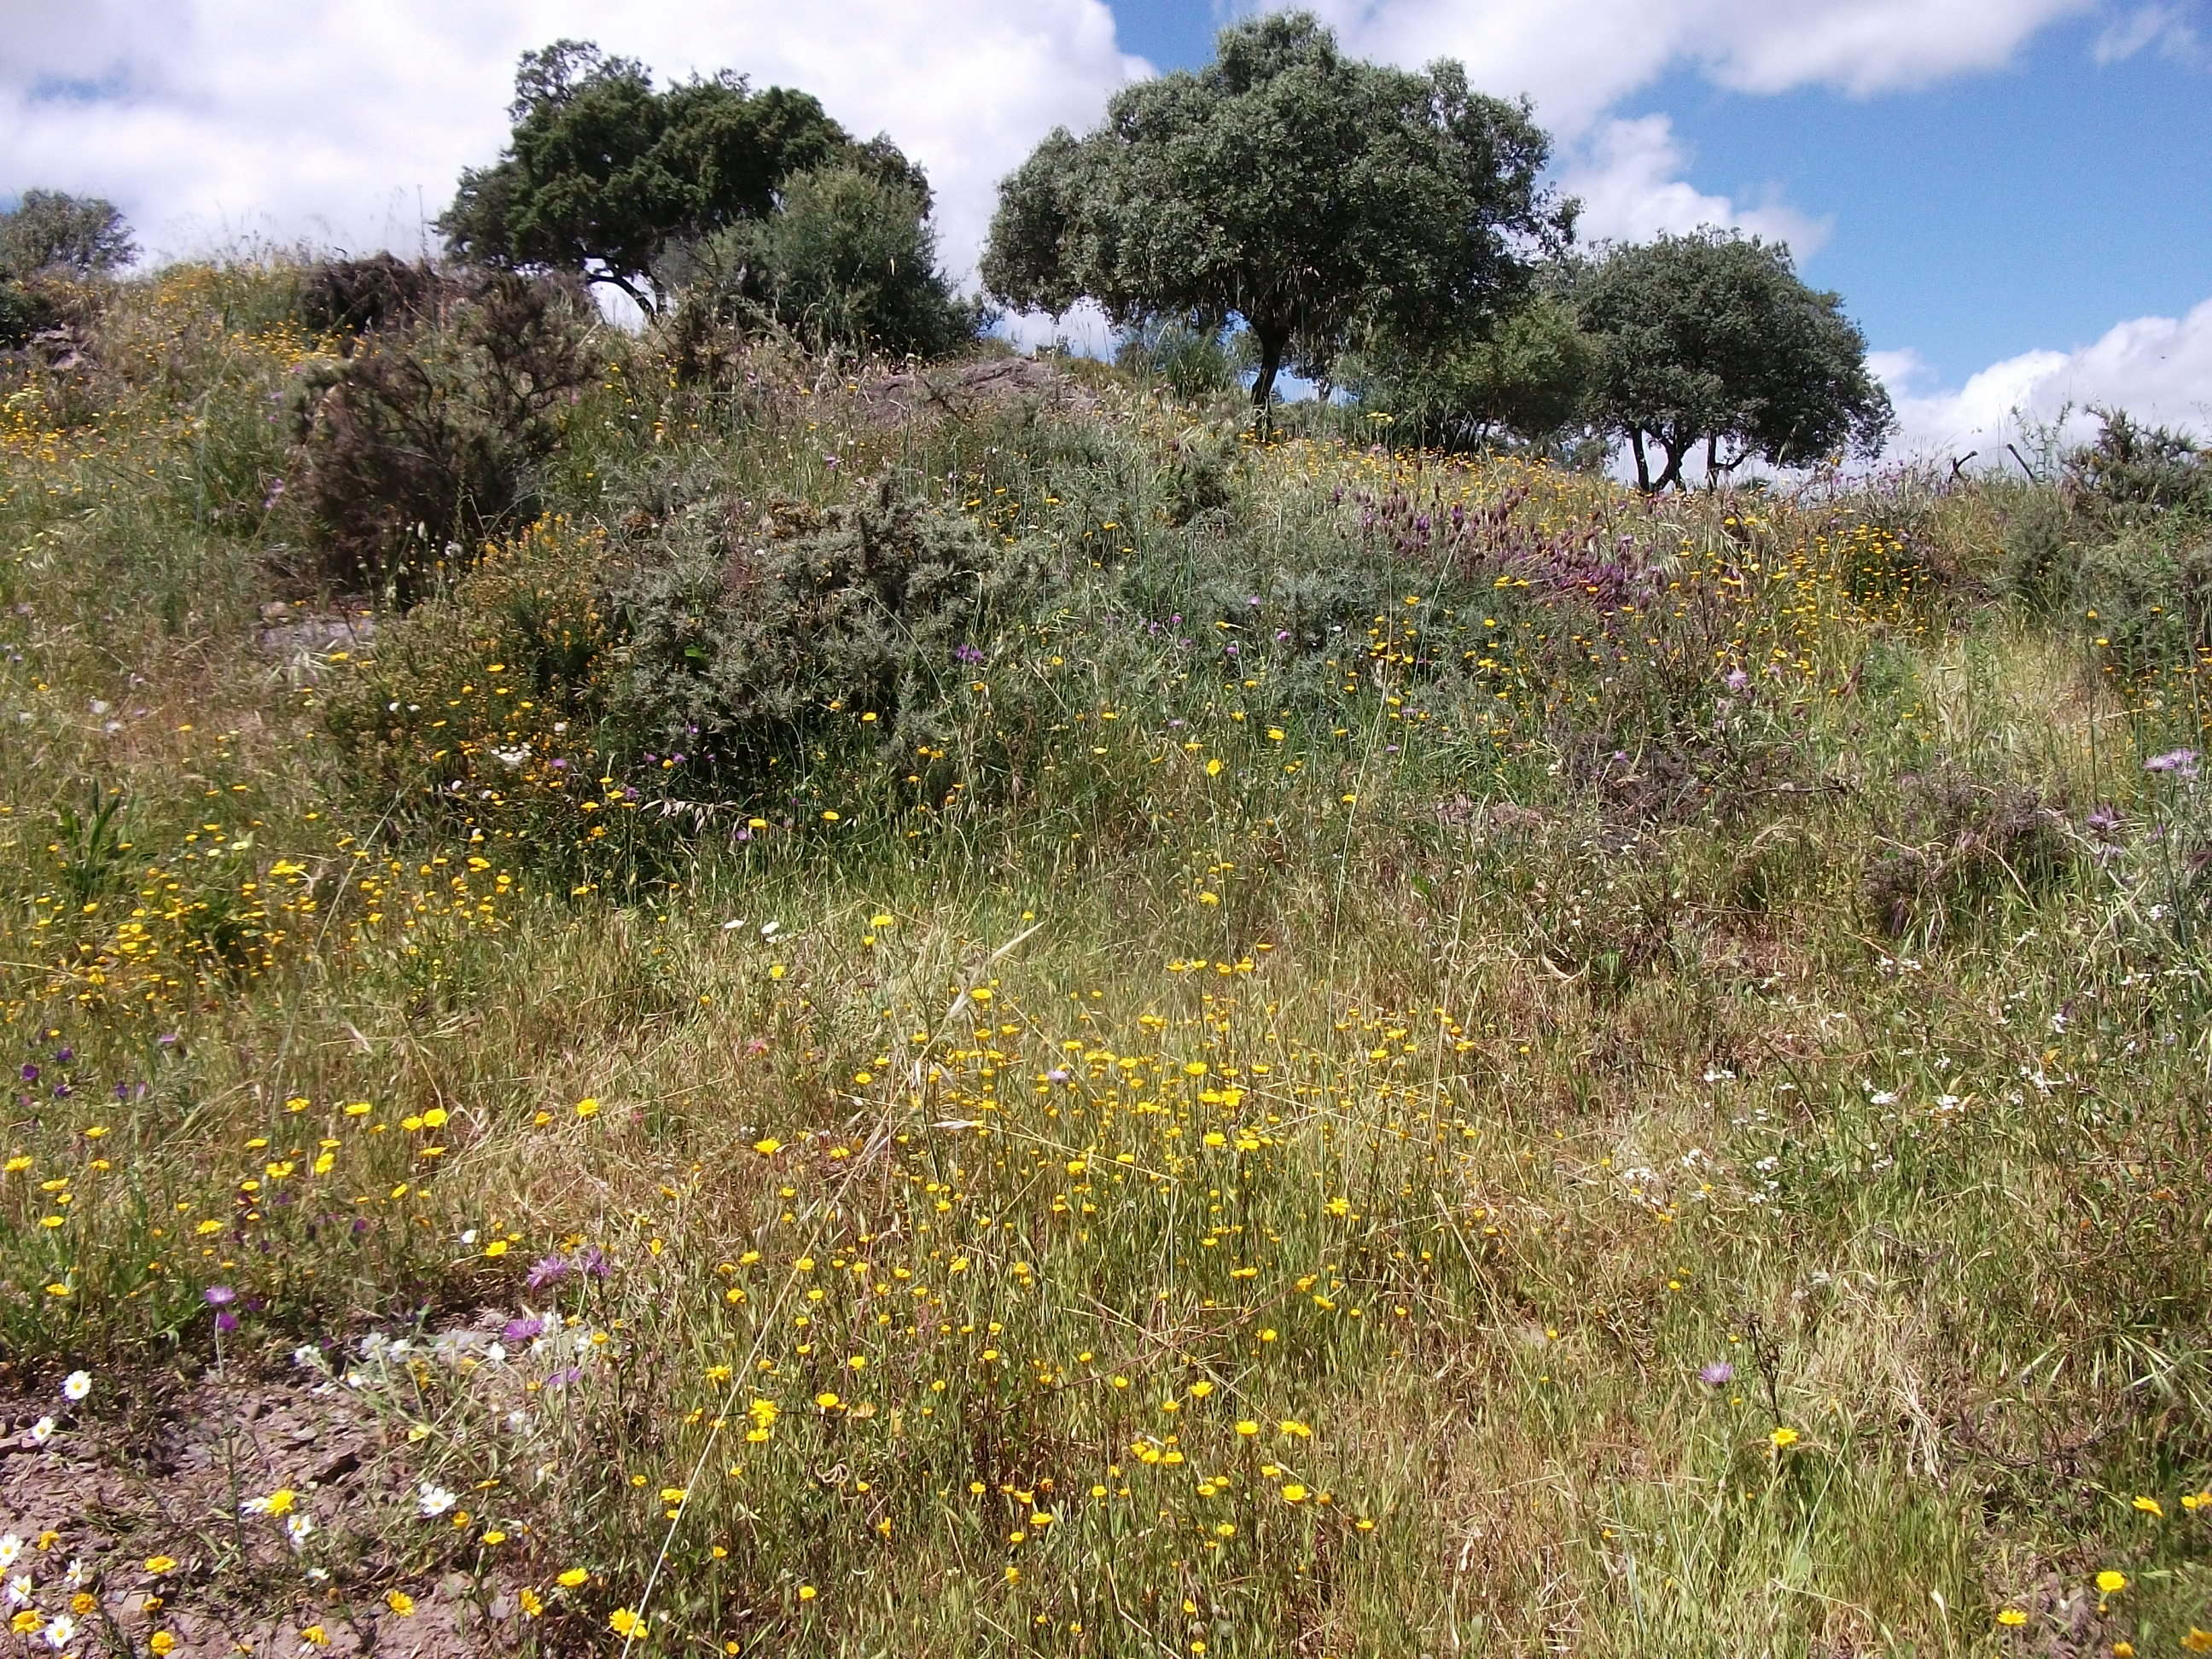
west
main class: Woodland
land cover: Broadleaved woodland
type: broadleaved evergreen forest
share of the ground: 10 - 25 %
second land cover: Grassland without tree/shrub cover
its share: > 75 %
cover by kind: herbaceous plants 85 %, broadleaved forest trees 10 %, shrubs 5 %
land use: Forestry
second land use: Agriculture (excluding fallow land and kitchen gardens)
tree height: > 5 m
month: May
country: ES
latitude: 37.6813
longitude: -6.6989
